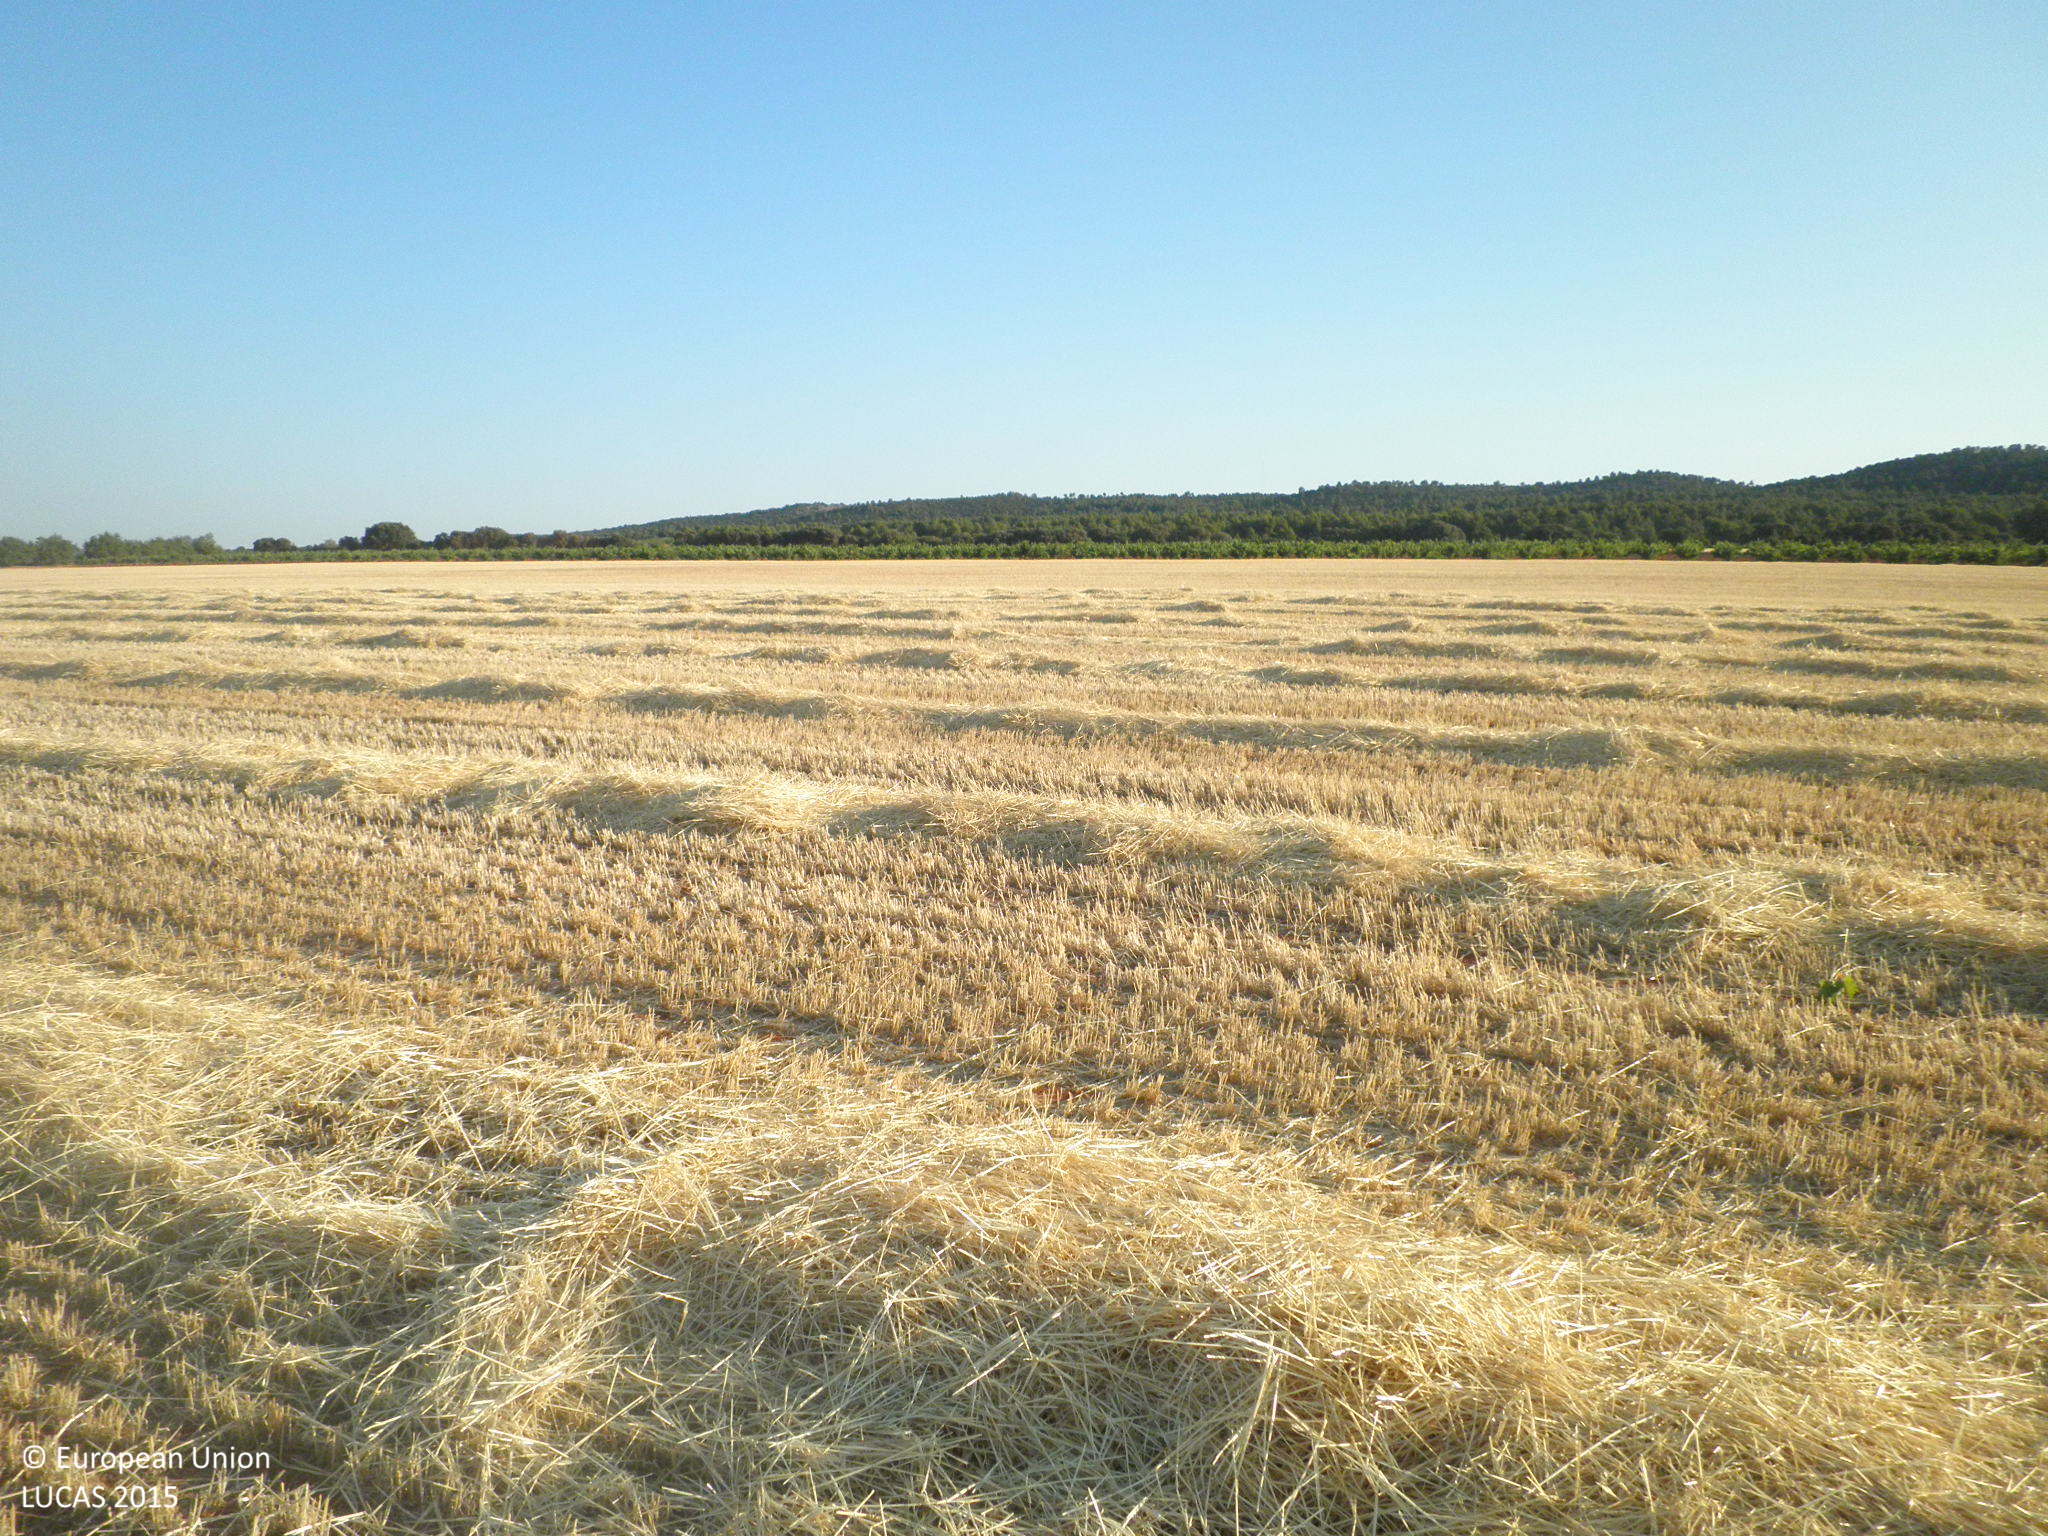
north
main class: Cropland
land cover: Barley
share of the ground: < 10 %
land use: Agriculture (excluding fallow land and kitchen gardens)
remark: Harvested field
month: July
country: ES
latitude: 39.5475
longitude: -1.8418
